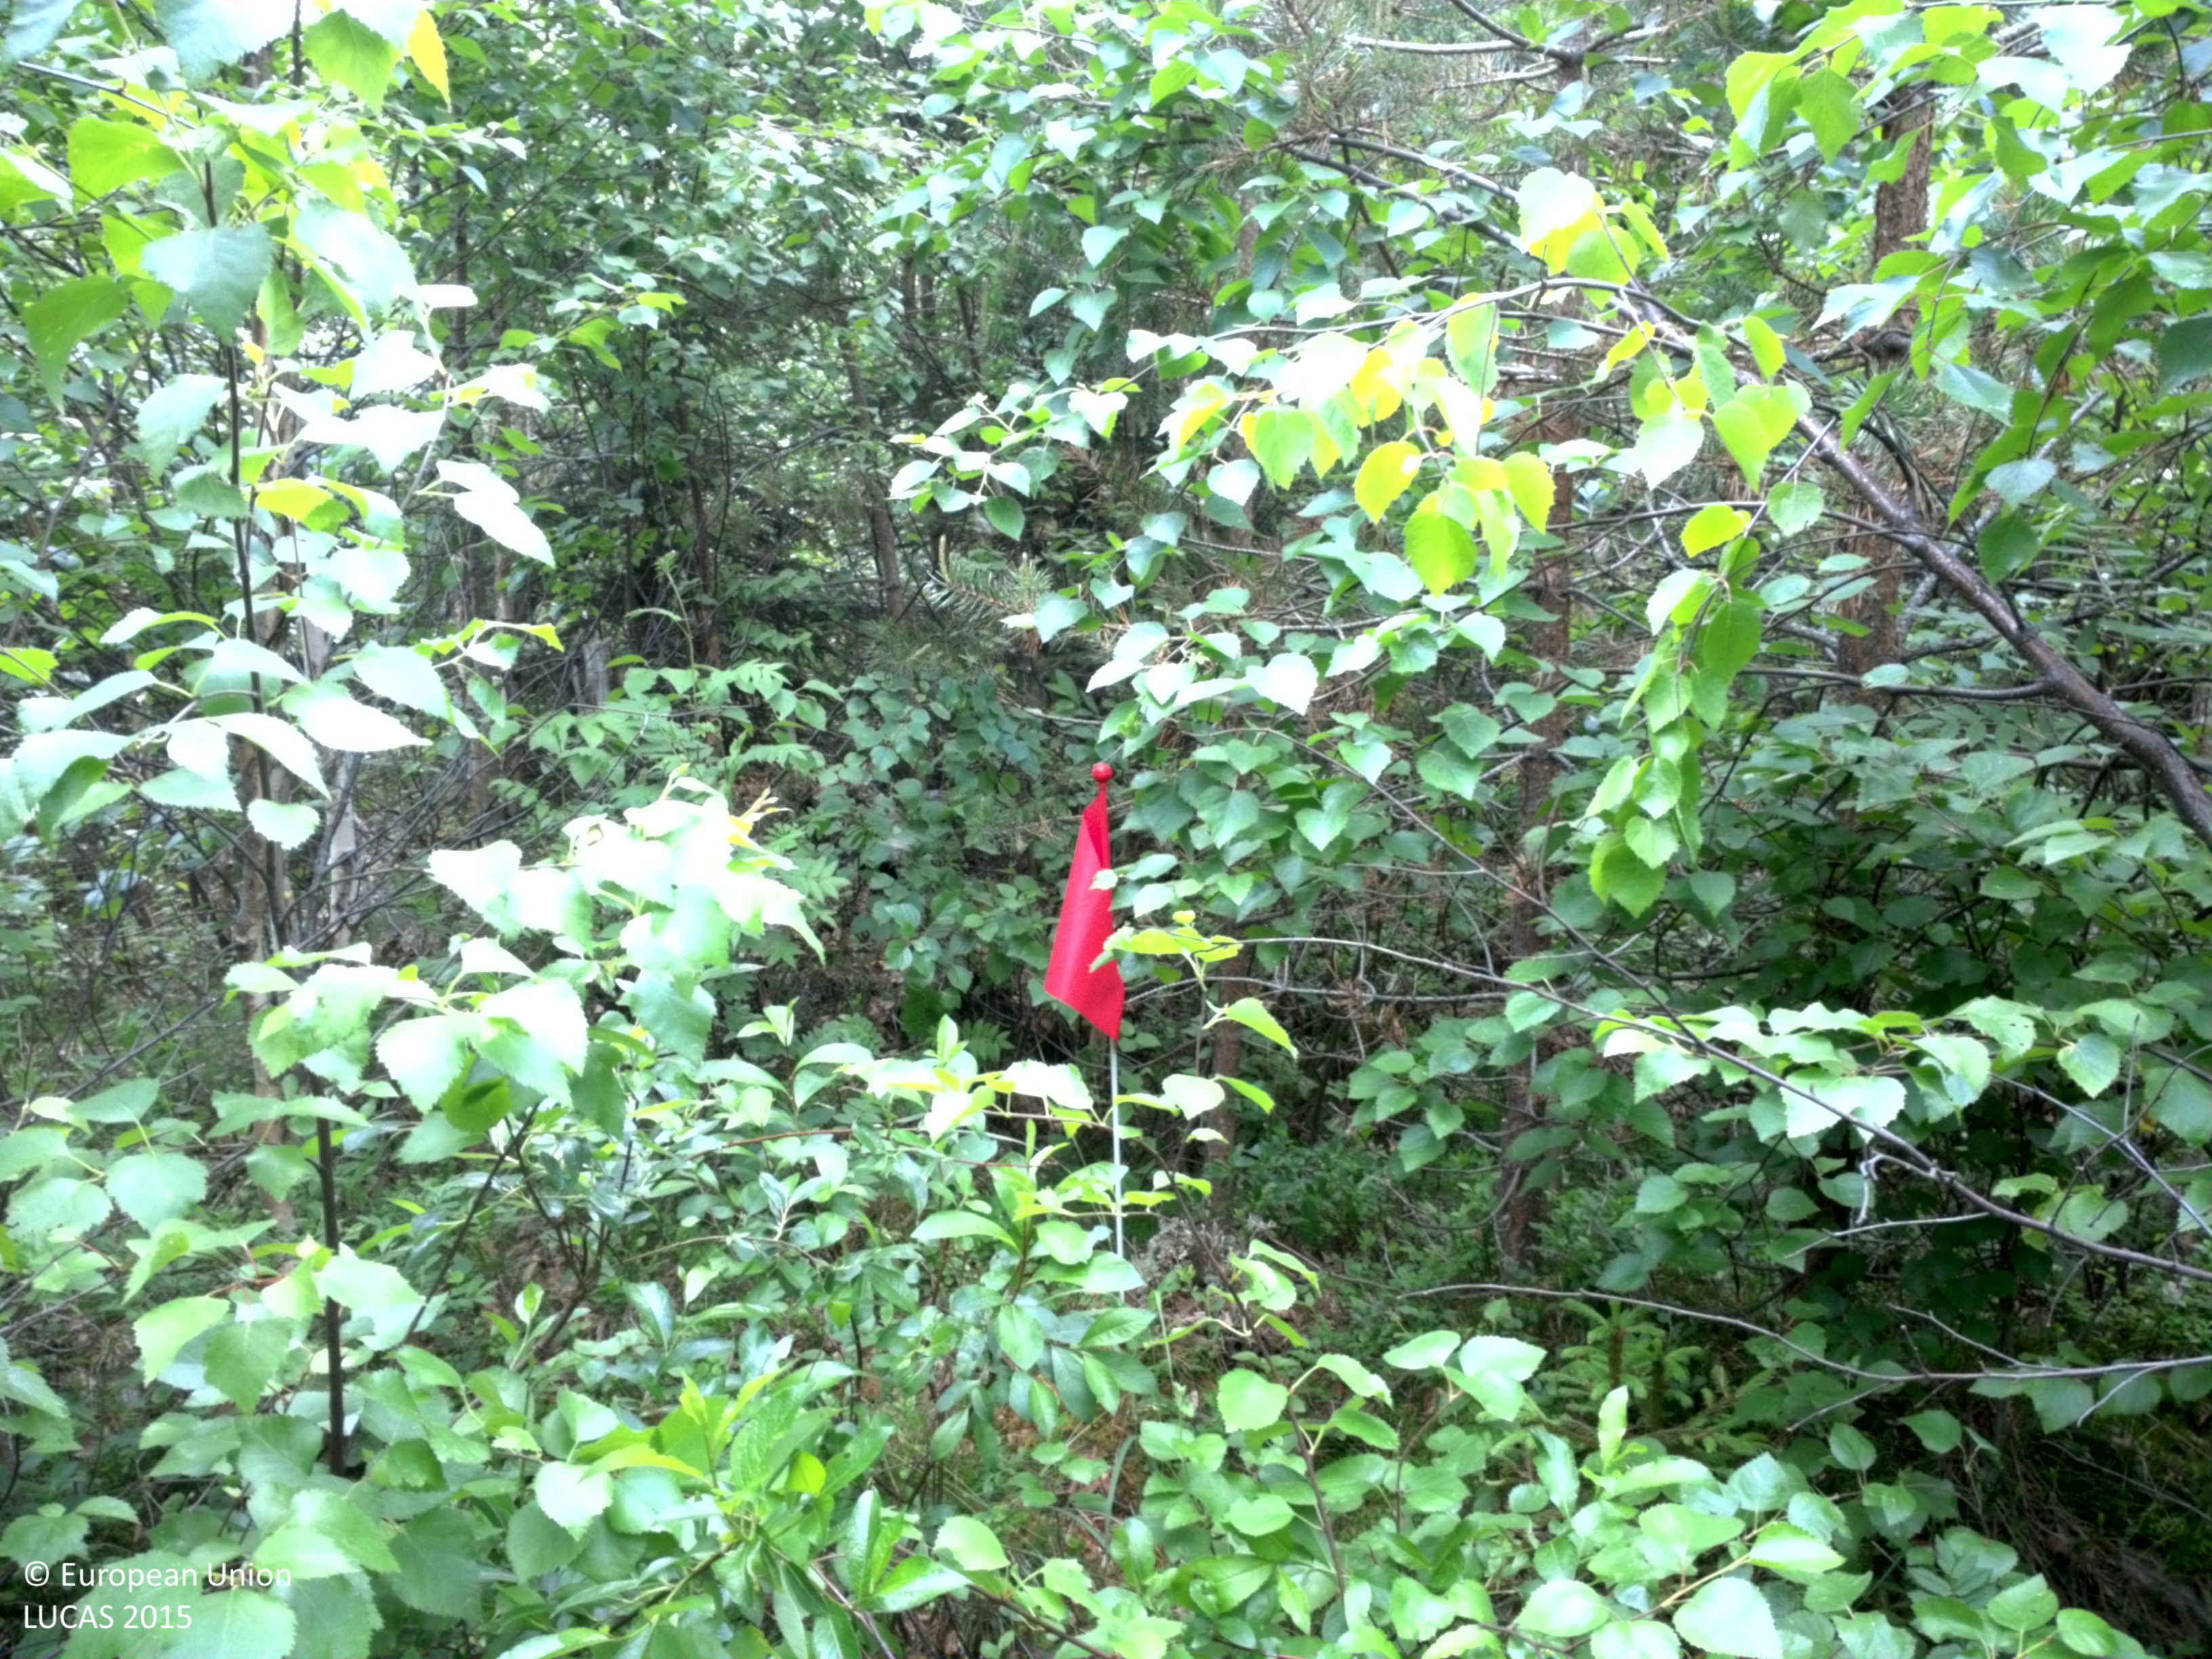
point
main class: Woodland
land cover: Pine dominated mixed woodland
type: boreal forest
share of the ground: > 75 %
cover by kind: broadleaved forest trees 60 %, coniferous forest trees 20 %, herbaceous plants 15 %, shrubs 5 %
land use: Forestry
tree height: < 5 m
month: July
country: SE
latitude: 64.3211
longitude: 20.7985
